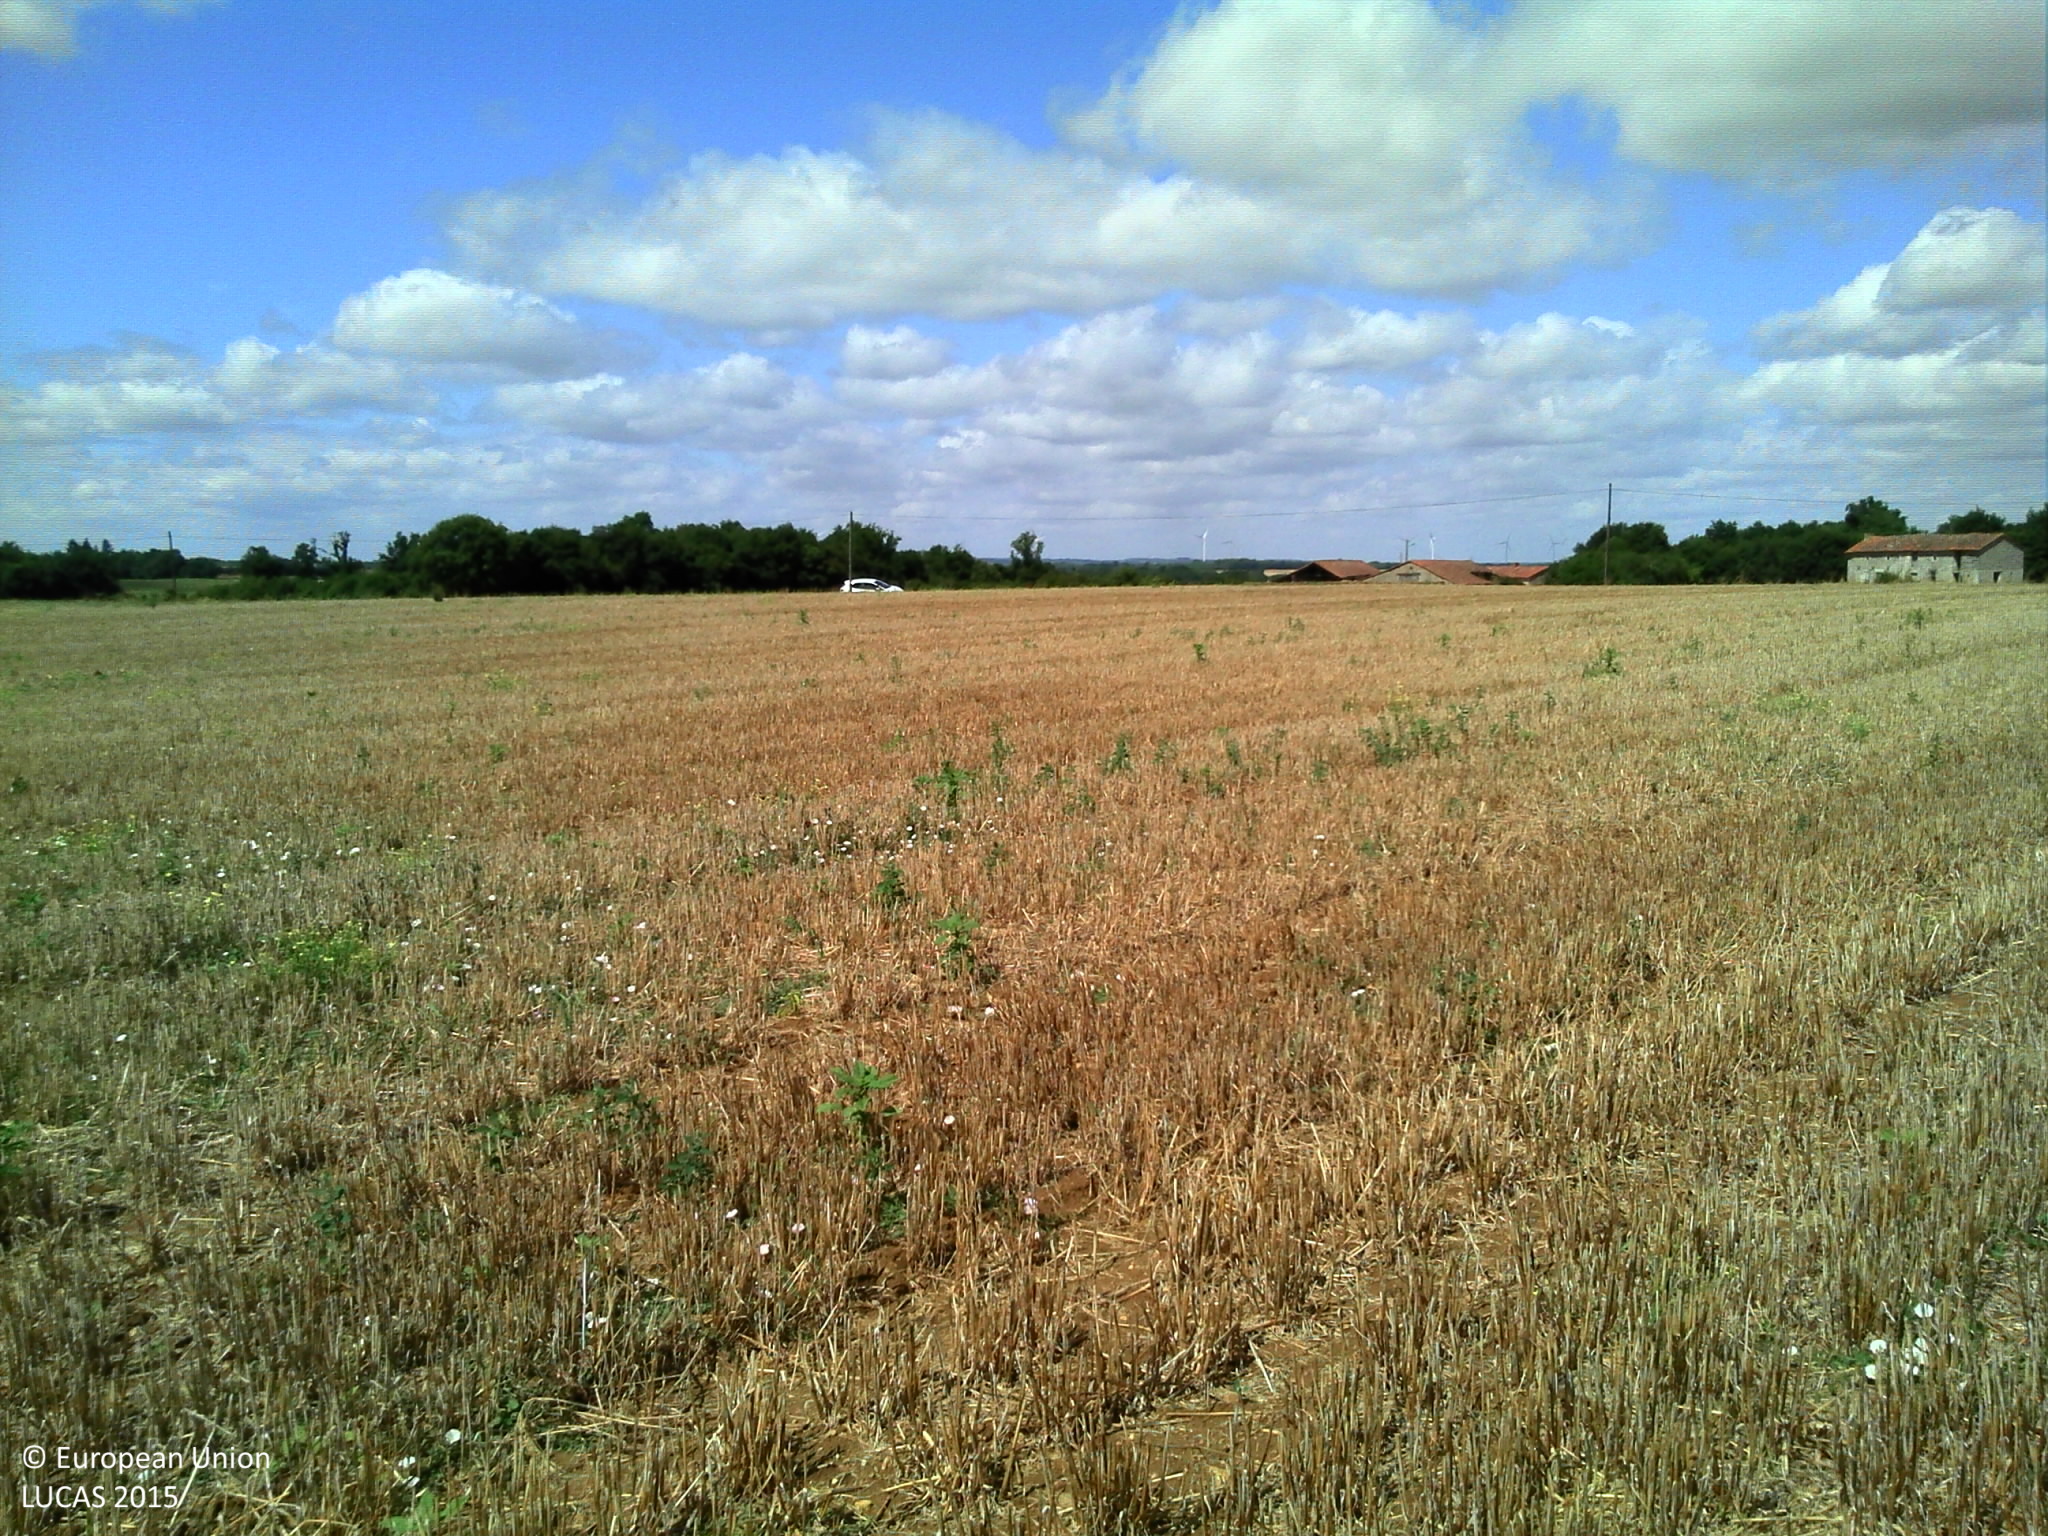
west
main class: Cropland
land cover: Barley
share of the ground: 50 - 75 %
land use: Agriculture (excluding fallow land and kitchen gardens)
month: August
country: FR
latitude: 46.0950
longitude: 0.3468
